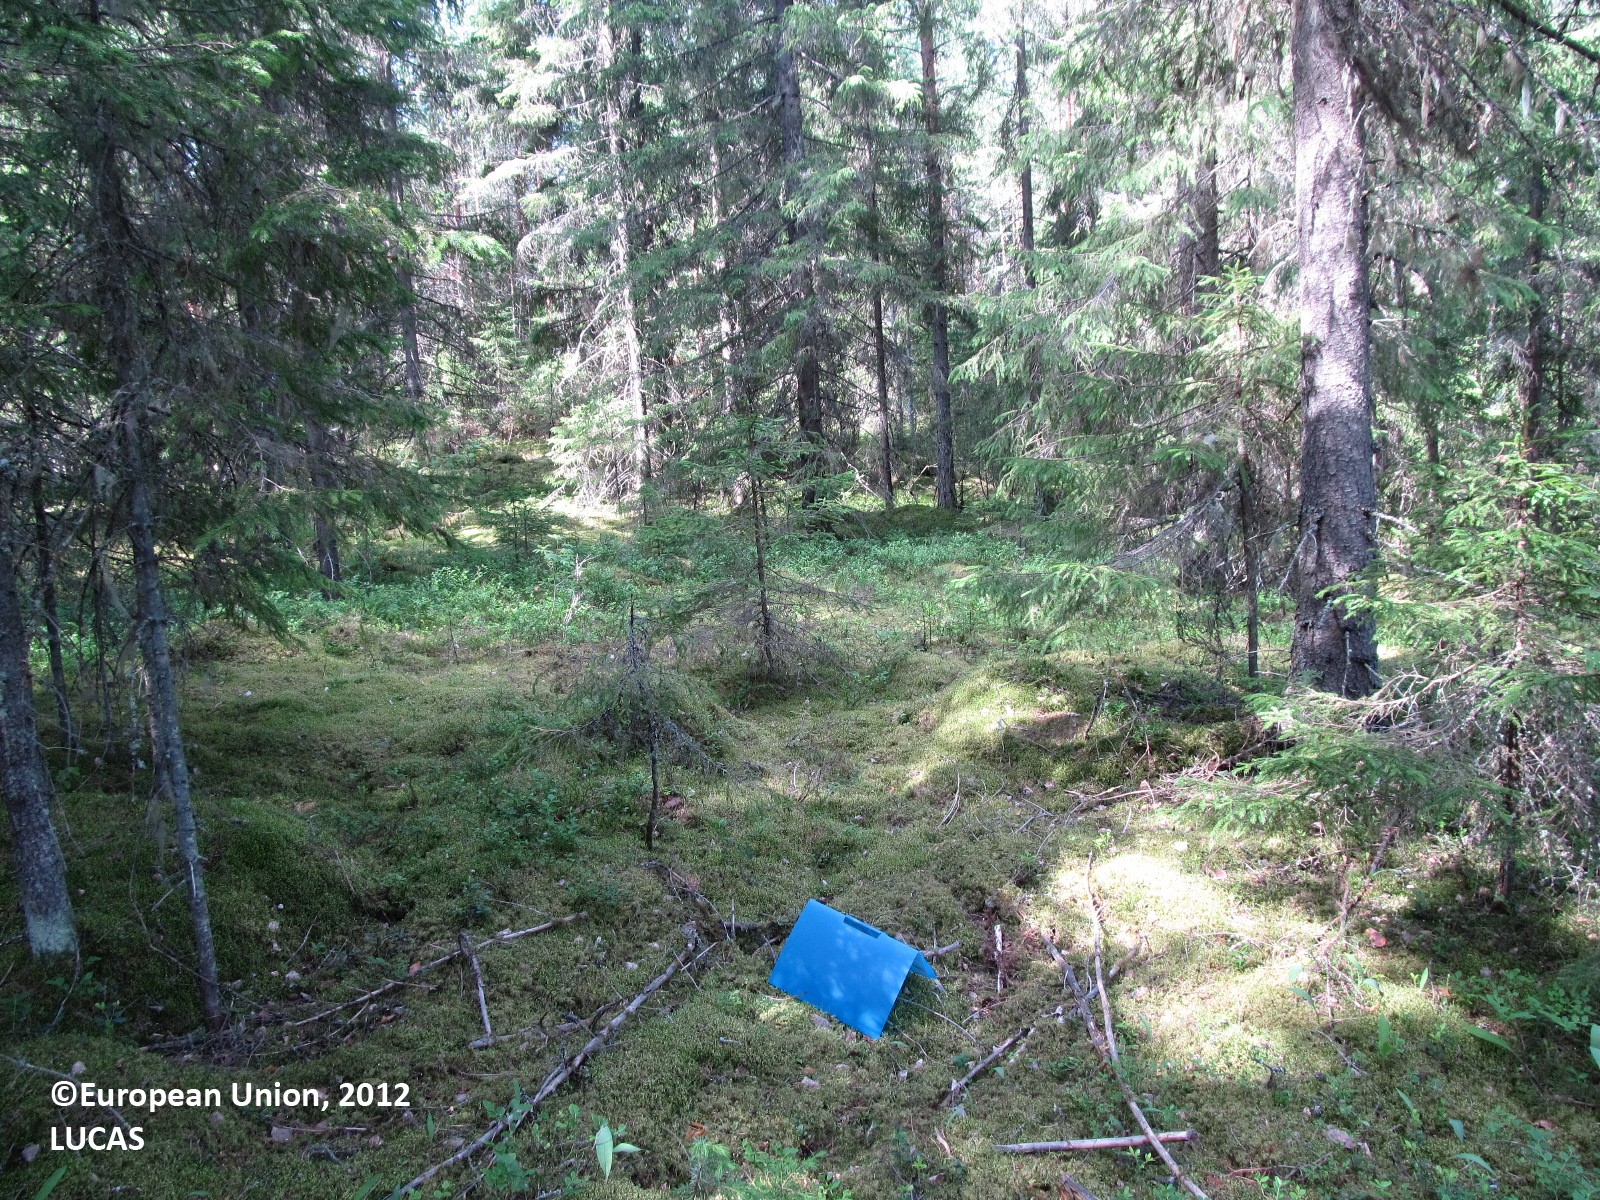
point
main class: Woodland
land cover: Spruce dominated coniferous woodland
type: boreal forest
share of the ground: 25 - 50 %
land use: Forestry
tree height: > 5 m
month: July
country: FI
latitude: 62.0023
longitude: 29.1150
